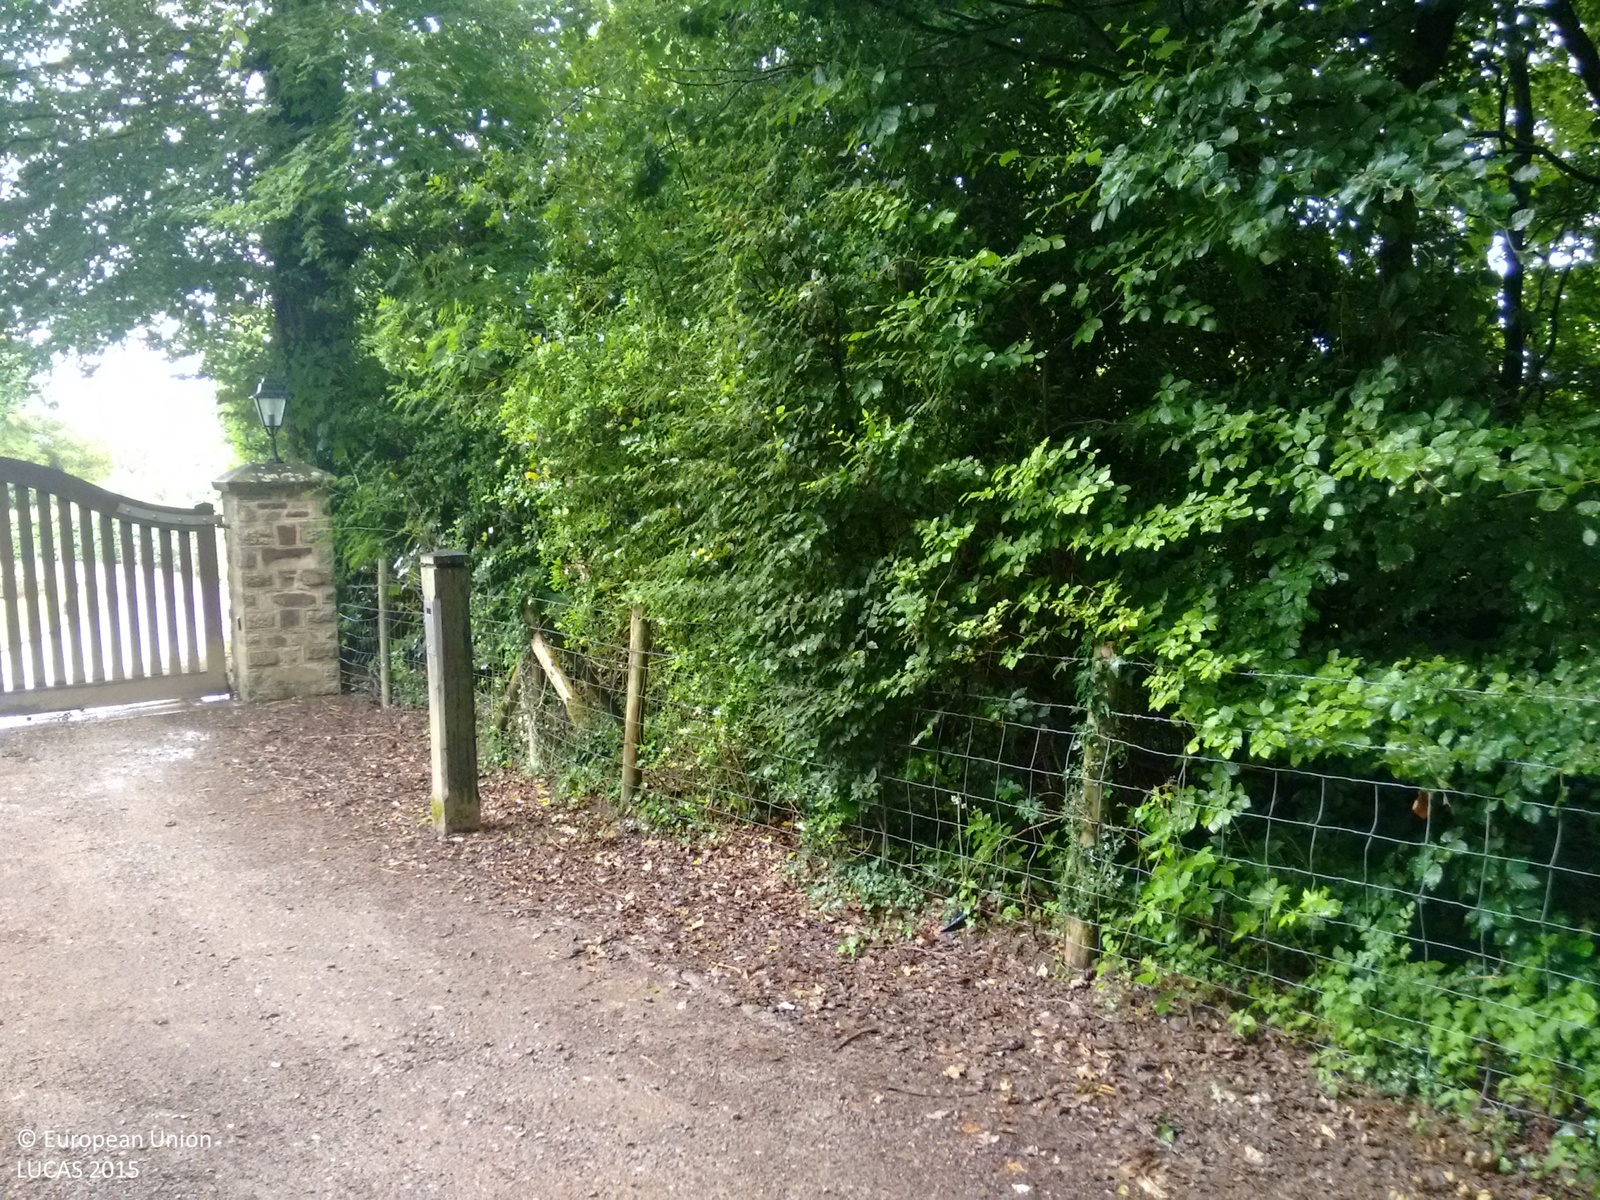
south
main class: Woodland
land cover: Broadleaved woodland
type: mesophytic deciduous forest
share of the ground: > 75 %
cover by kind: broadleaved forest trees 100 %
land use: Residential
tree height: > 5 m
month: July
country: GB
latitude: 51.0325
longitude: -3.5317
